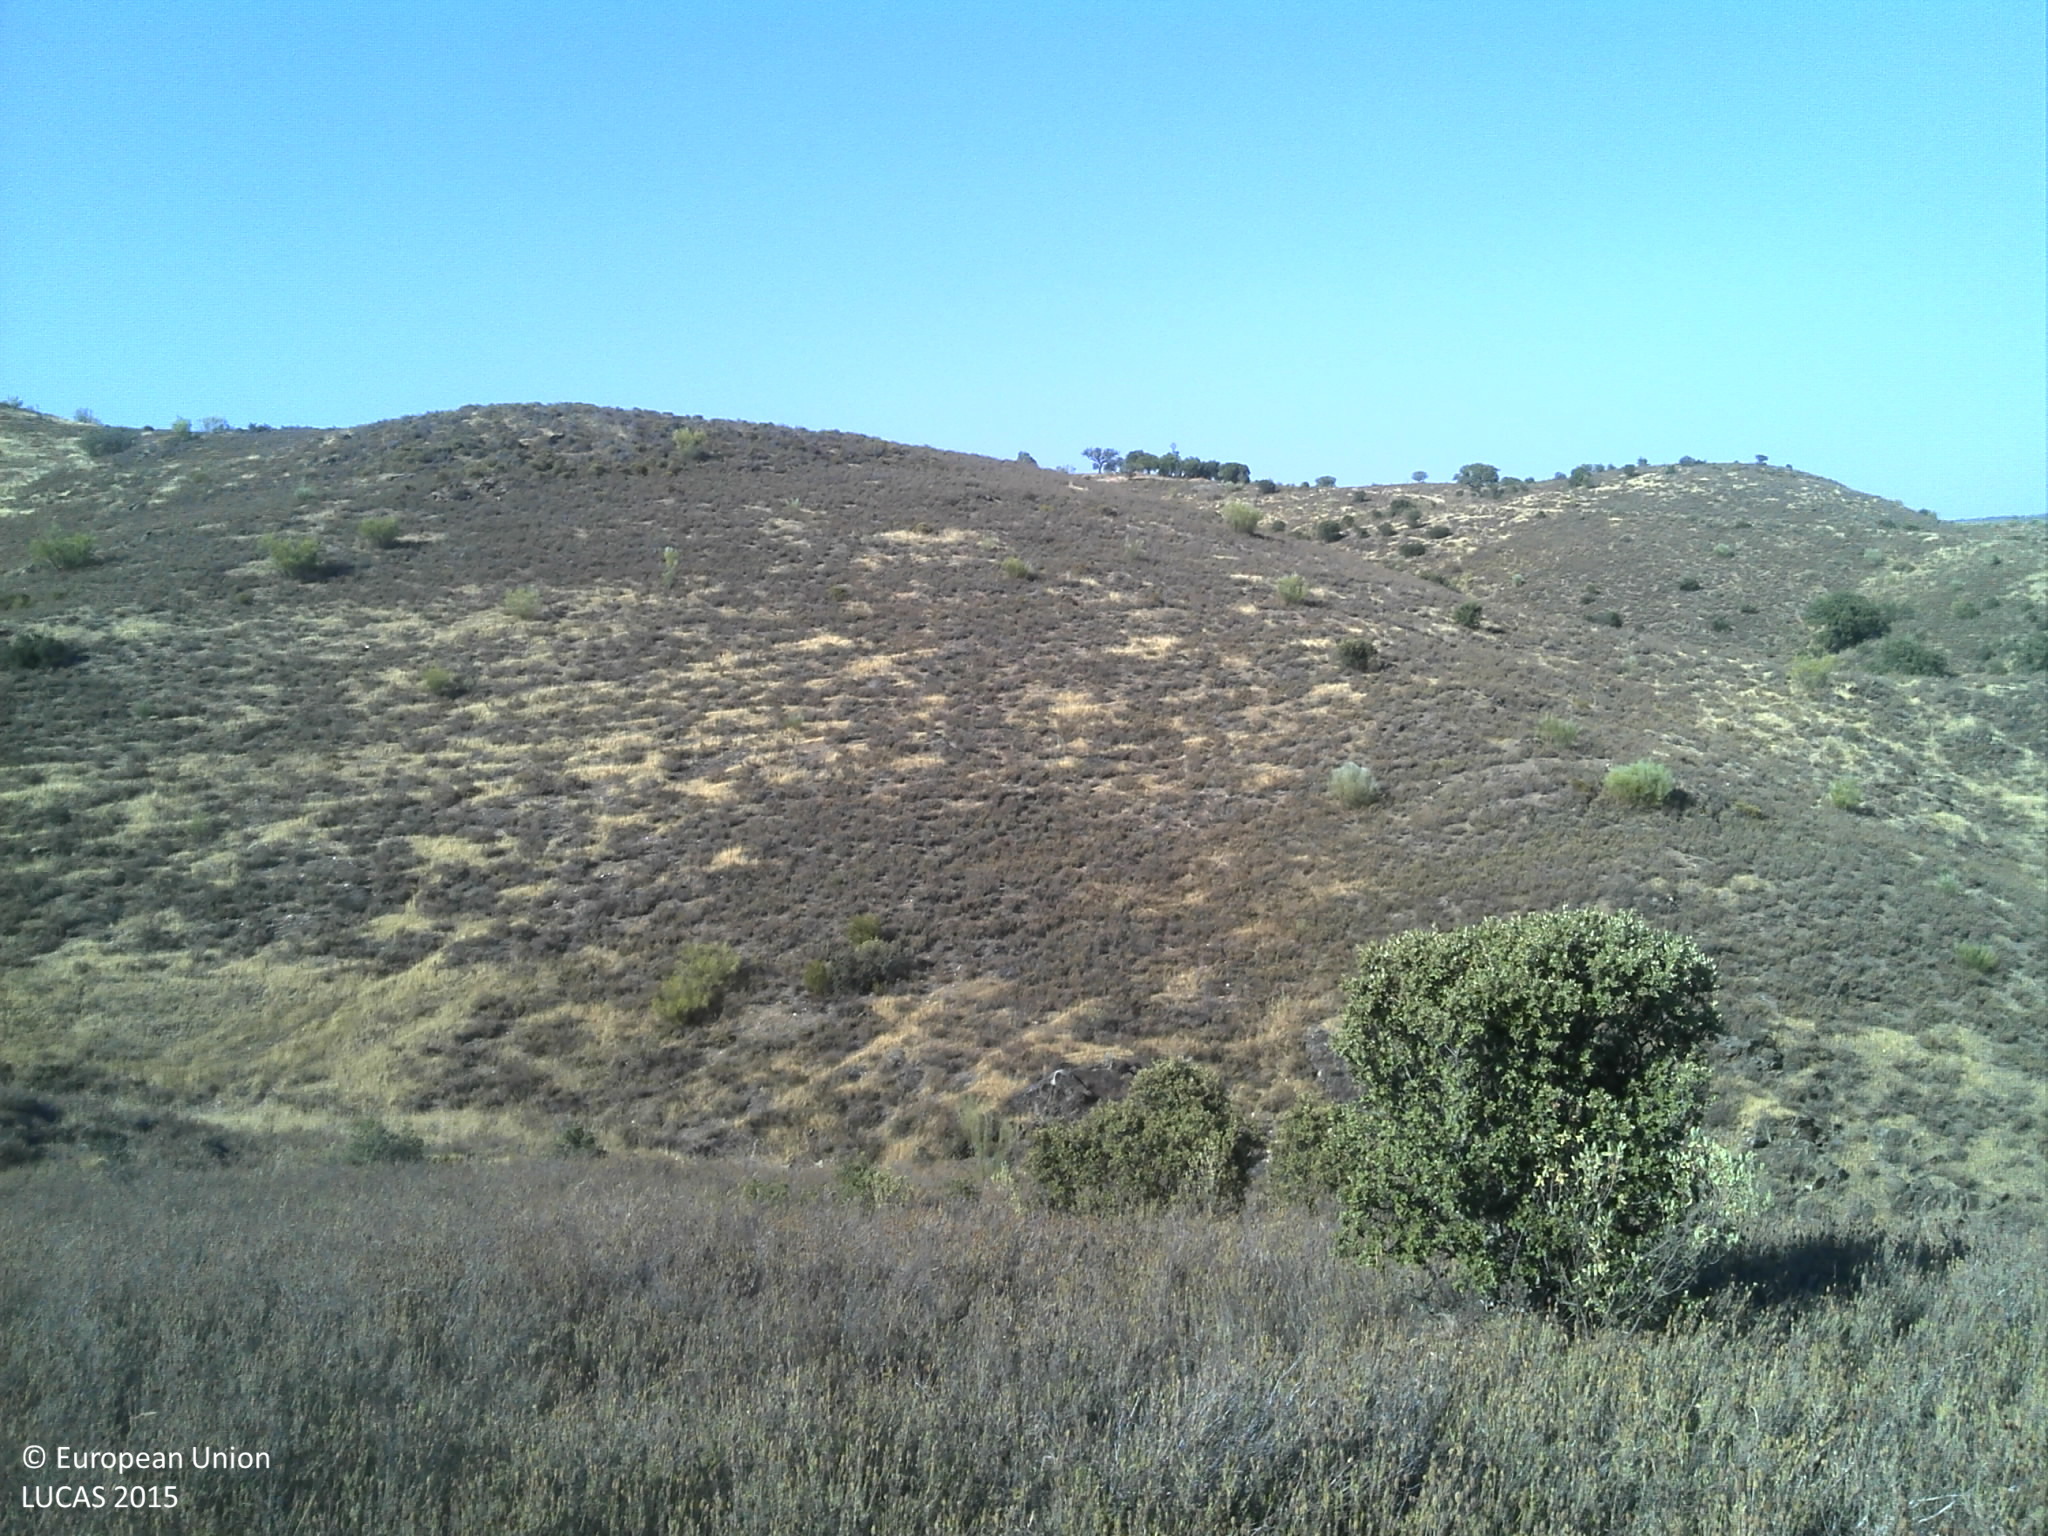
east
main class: Shrubland
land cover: Shrubland without tree cover
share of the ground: 50 - 75 %
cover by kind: shrubs 70 %, herbaceous plants 15 %, unconsolidated bare surface 10 %
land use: Abandoned areas
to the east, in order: Shrubland without tree cover; Rivers and streams; Shrubland without tree cover; Rivers and streams; Shrubland without tree cover
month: June
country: PT
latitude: 39.7304
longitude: -7.2068
